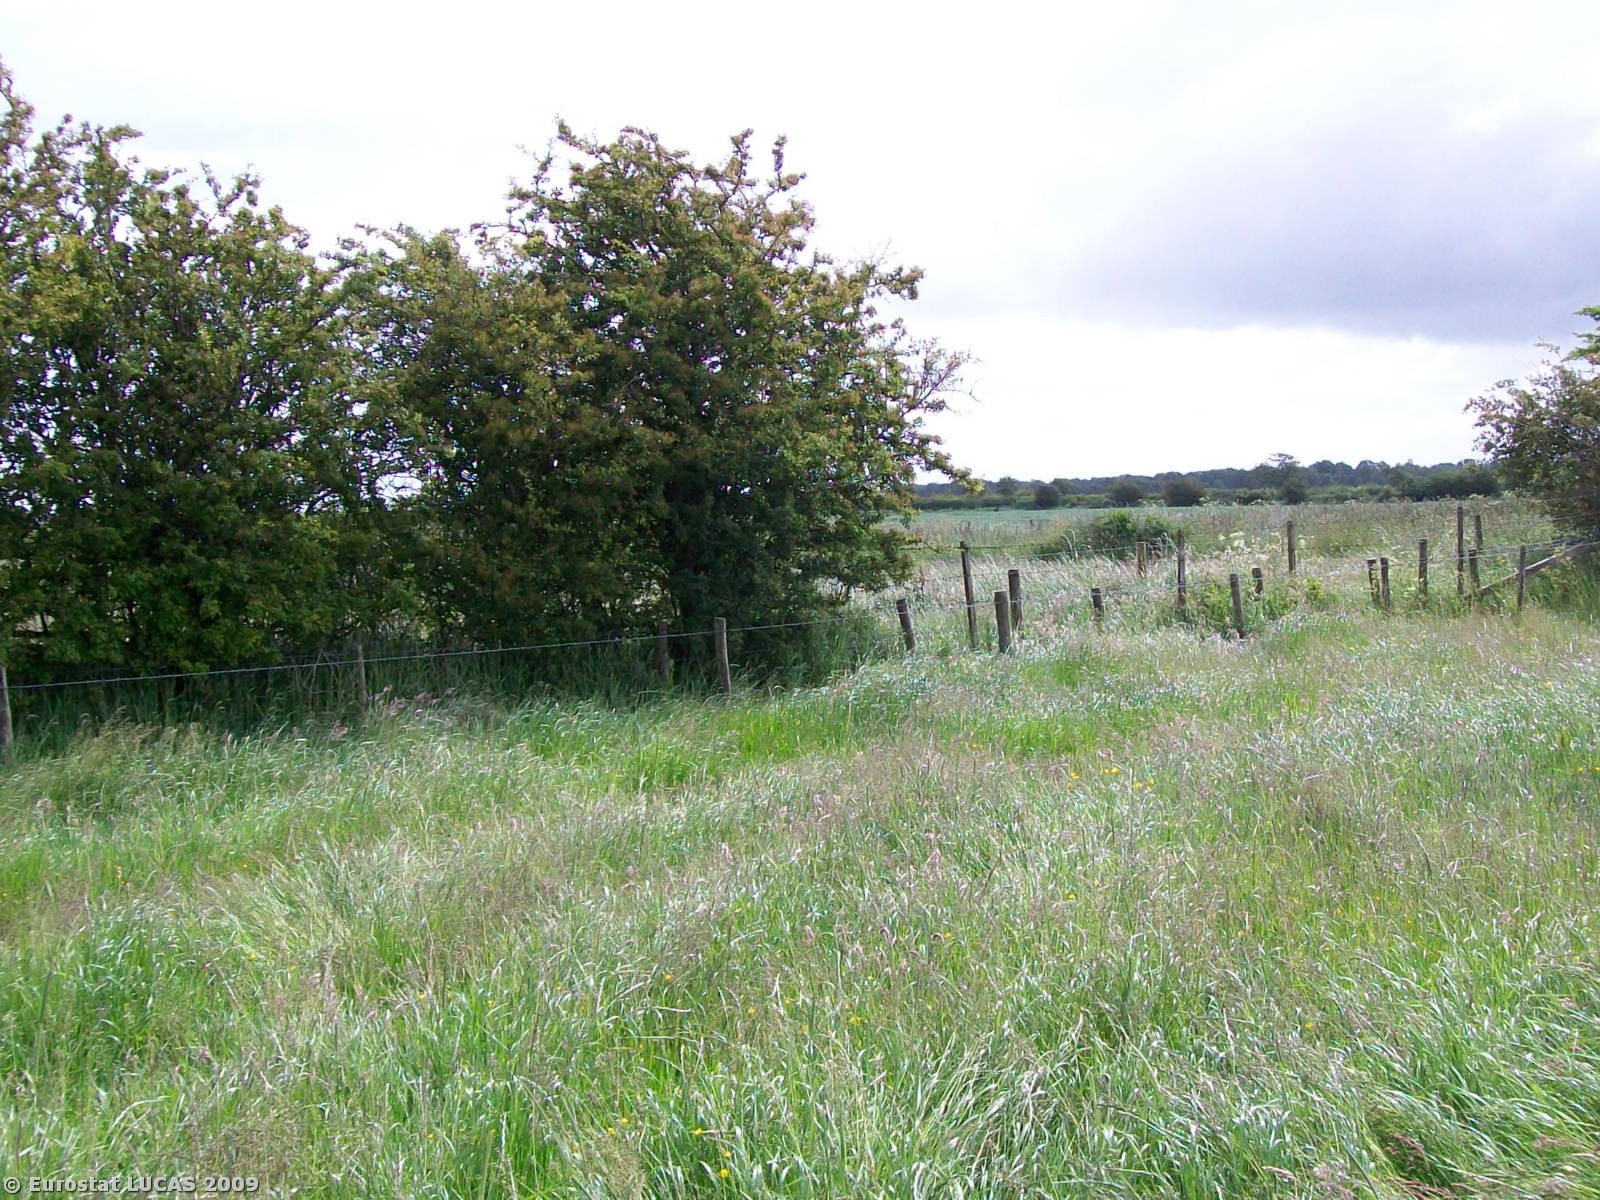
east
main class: Grassland
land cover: Grassland without tree/shrub cover
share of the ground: > 75 %
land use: Agriculture (excluding fallow land and kitchen gardens)
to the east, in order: Grassland without tree/shrub cover; Fences; Abandoned hedges; Fences; Grassland without tree/shrub cover; Other structural elements; Grassland without tree/shrub cover; Fences; Barley
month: June
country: GB
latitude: 54.8767
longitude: -3.2456
